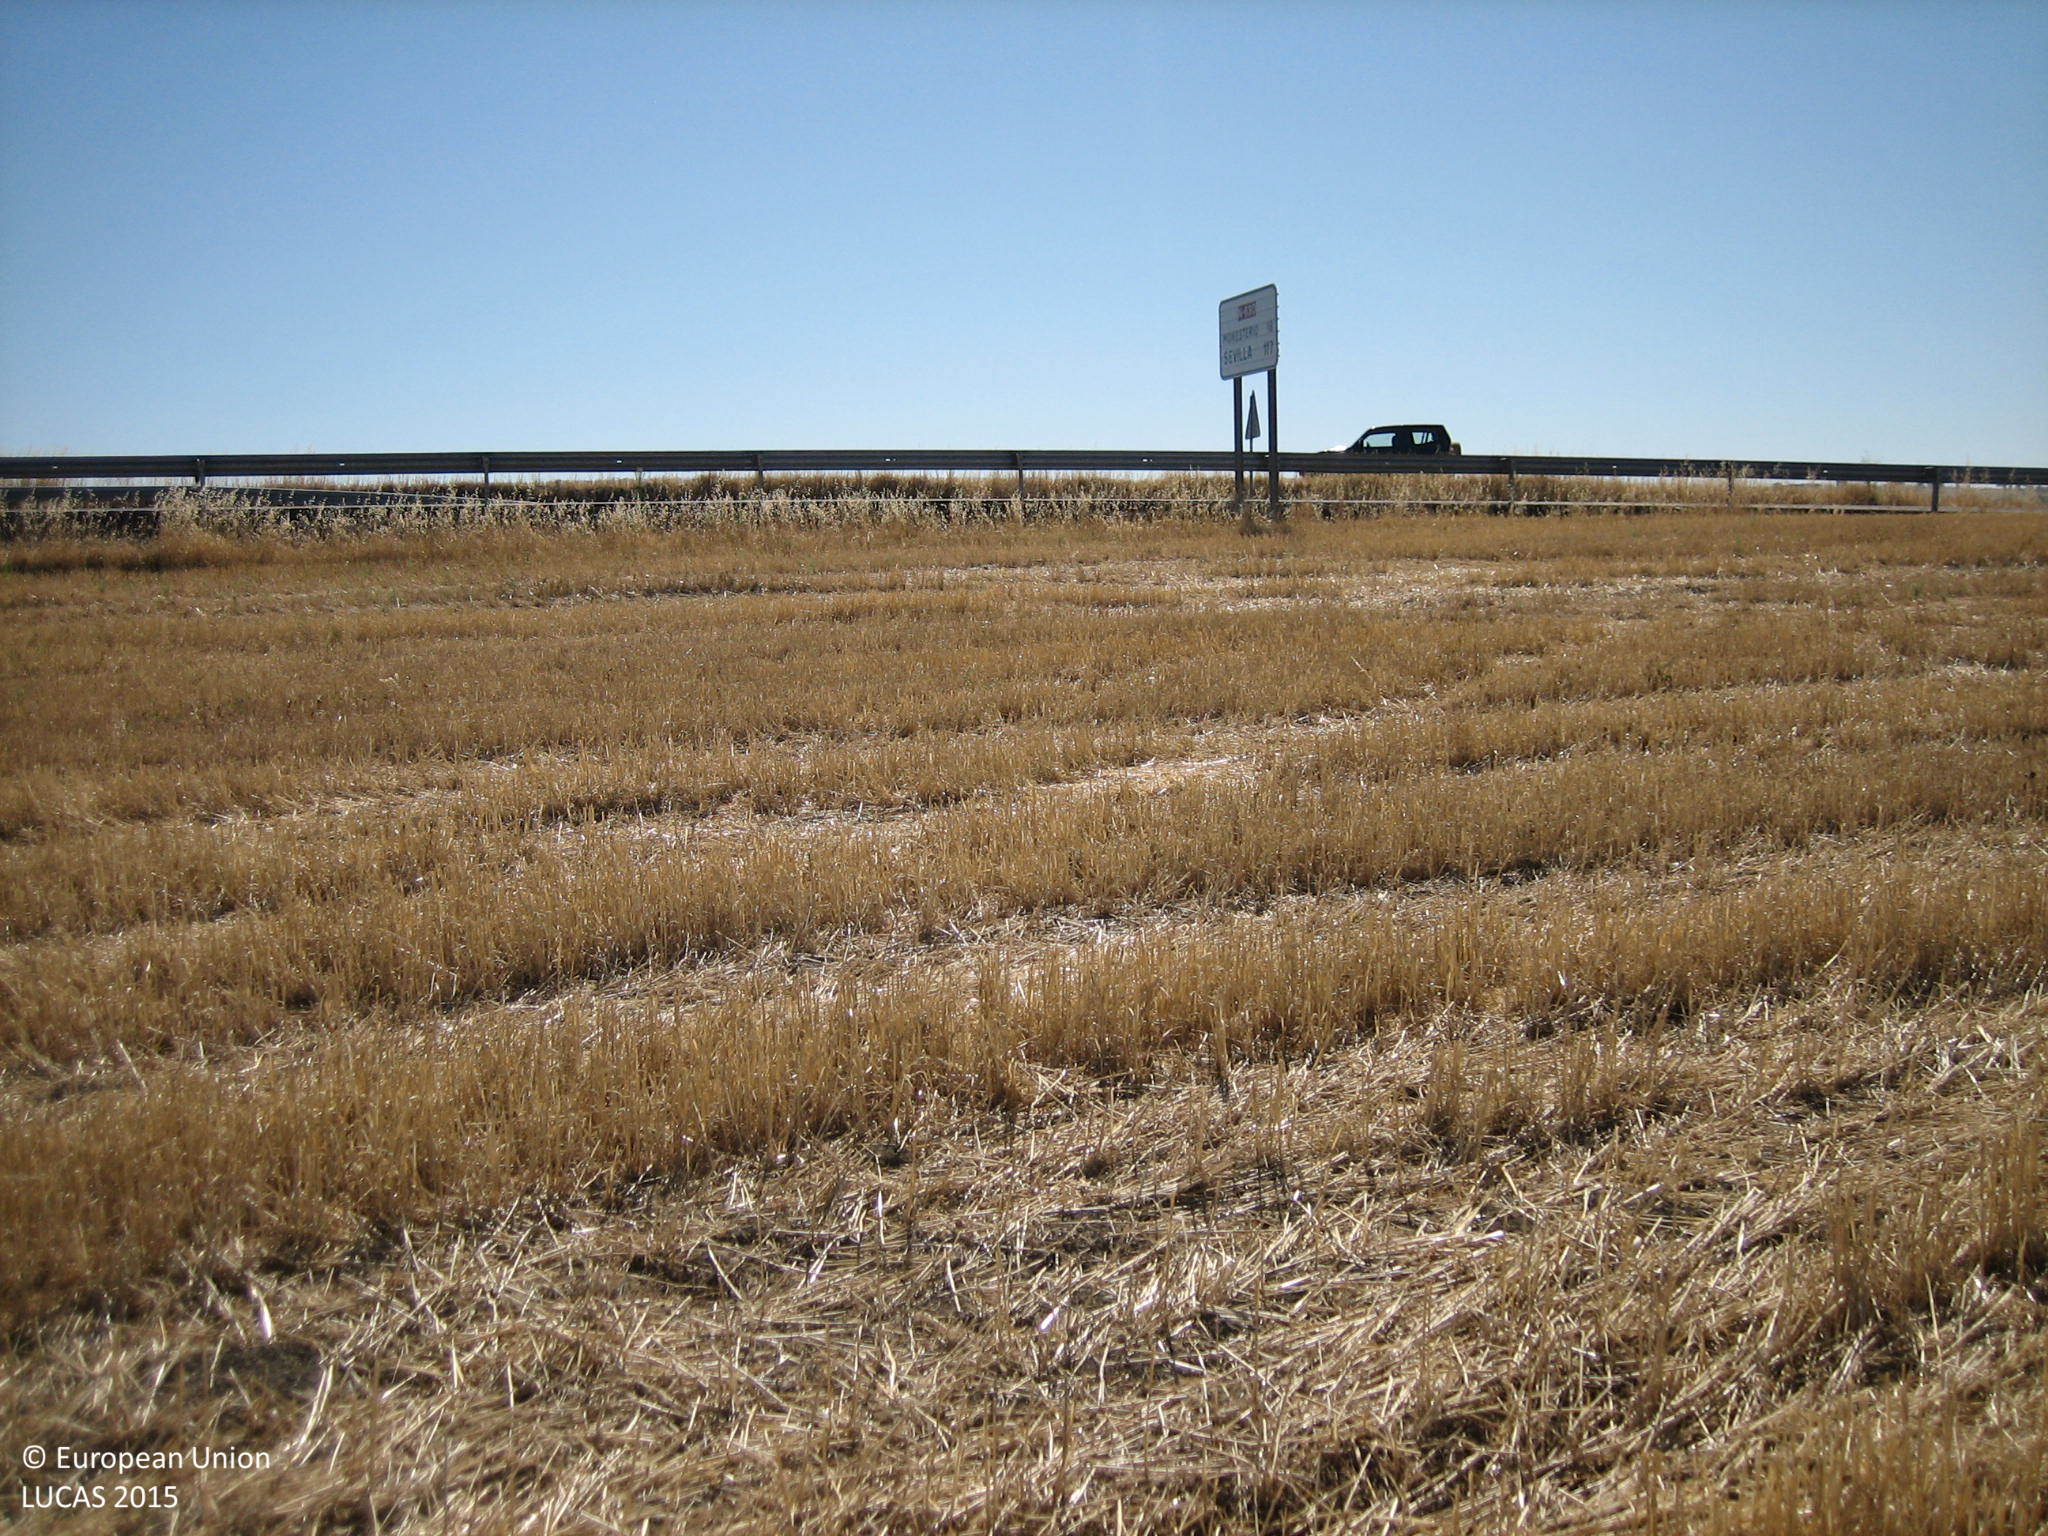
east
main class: Cropland
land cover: Common wheat
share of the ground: < 10 %
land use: Agriculture (excluding fallow land and kitchen gardens)
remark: Harvested field
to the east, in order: Common wheat; Paved roads, cycling and walking lanes; Oats; Grass margins; Other bare soil; Grass margins; Other bare soil
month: July
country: ES
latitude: 38.2304
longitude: -6.3008
